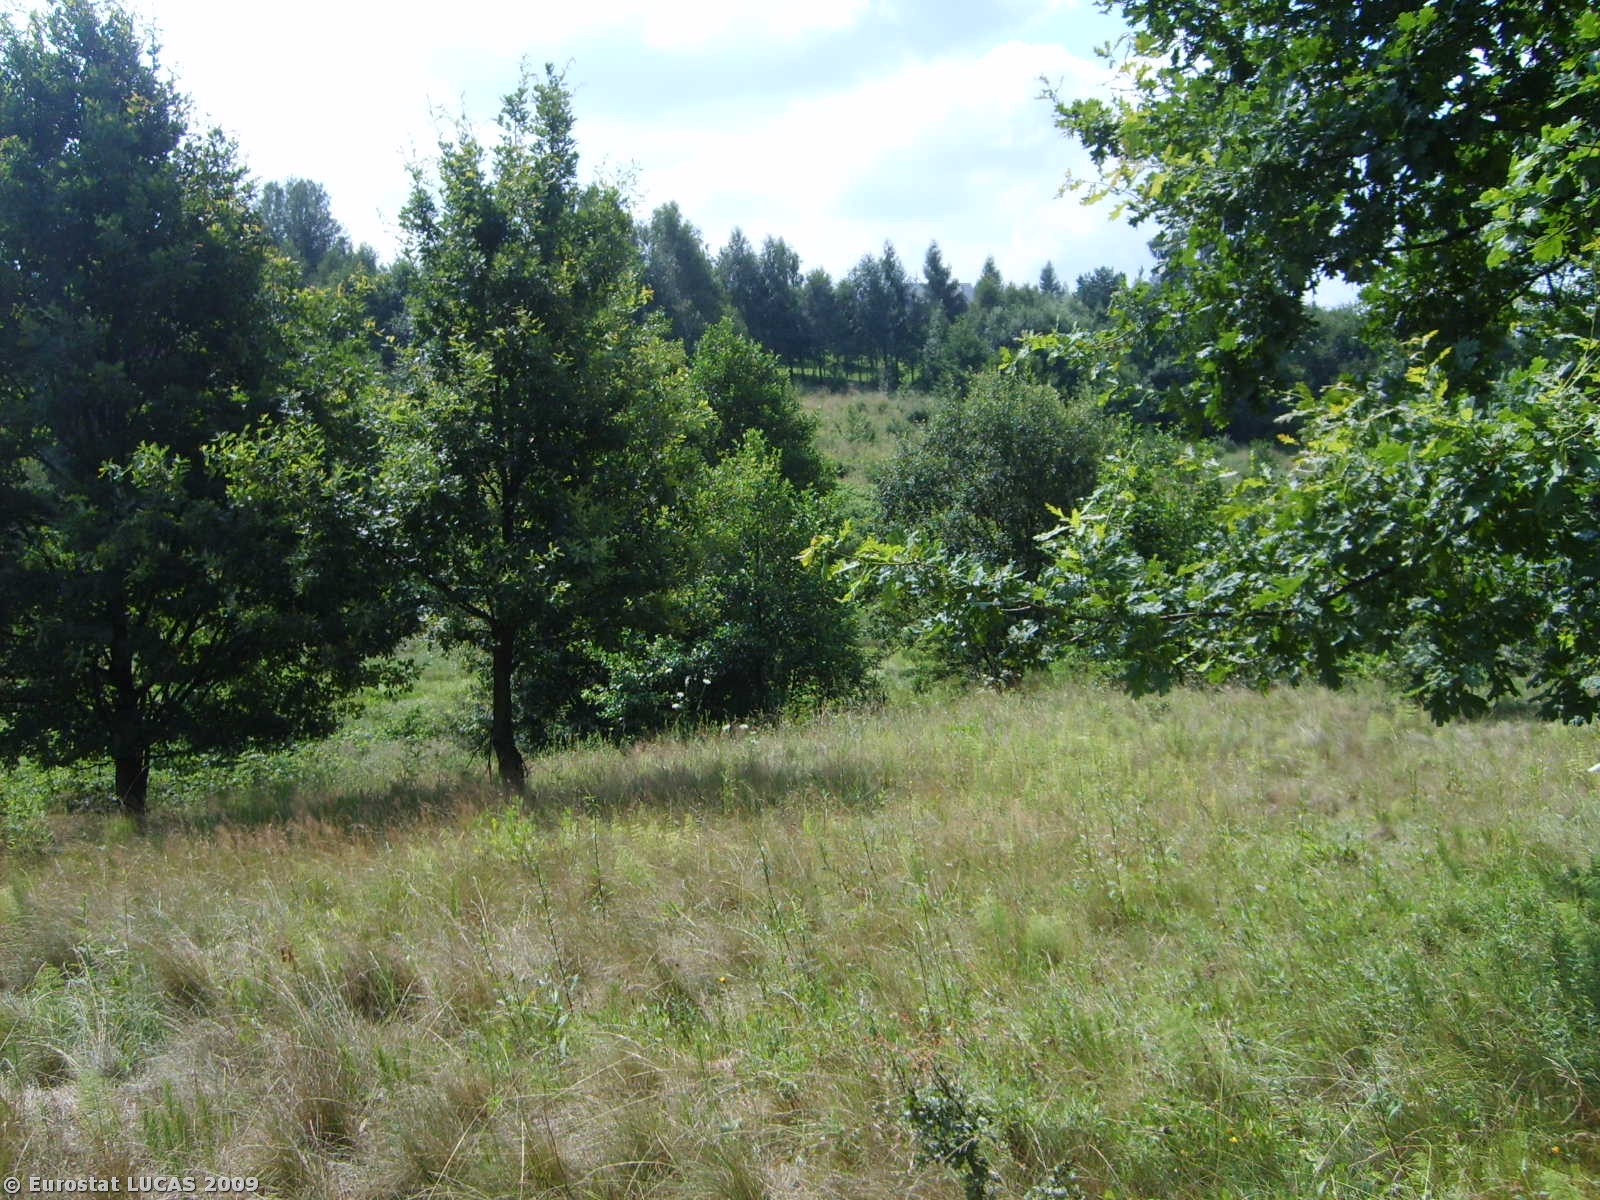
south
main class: Grassland
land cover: Grassland without tree/shrub cover
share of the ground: > 75 %
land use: Unused
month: July
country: PL
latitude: 49.9813
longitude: 19.9751
